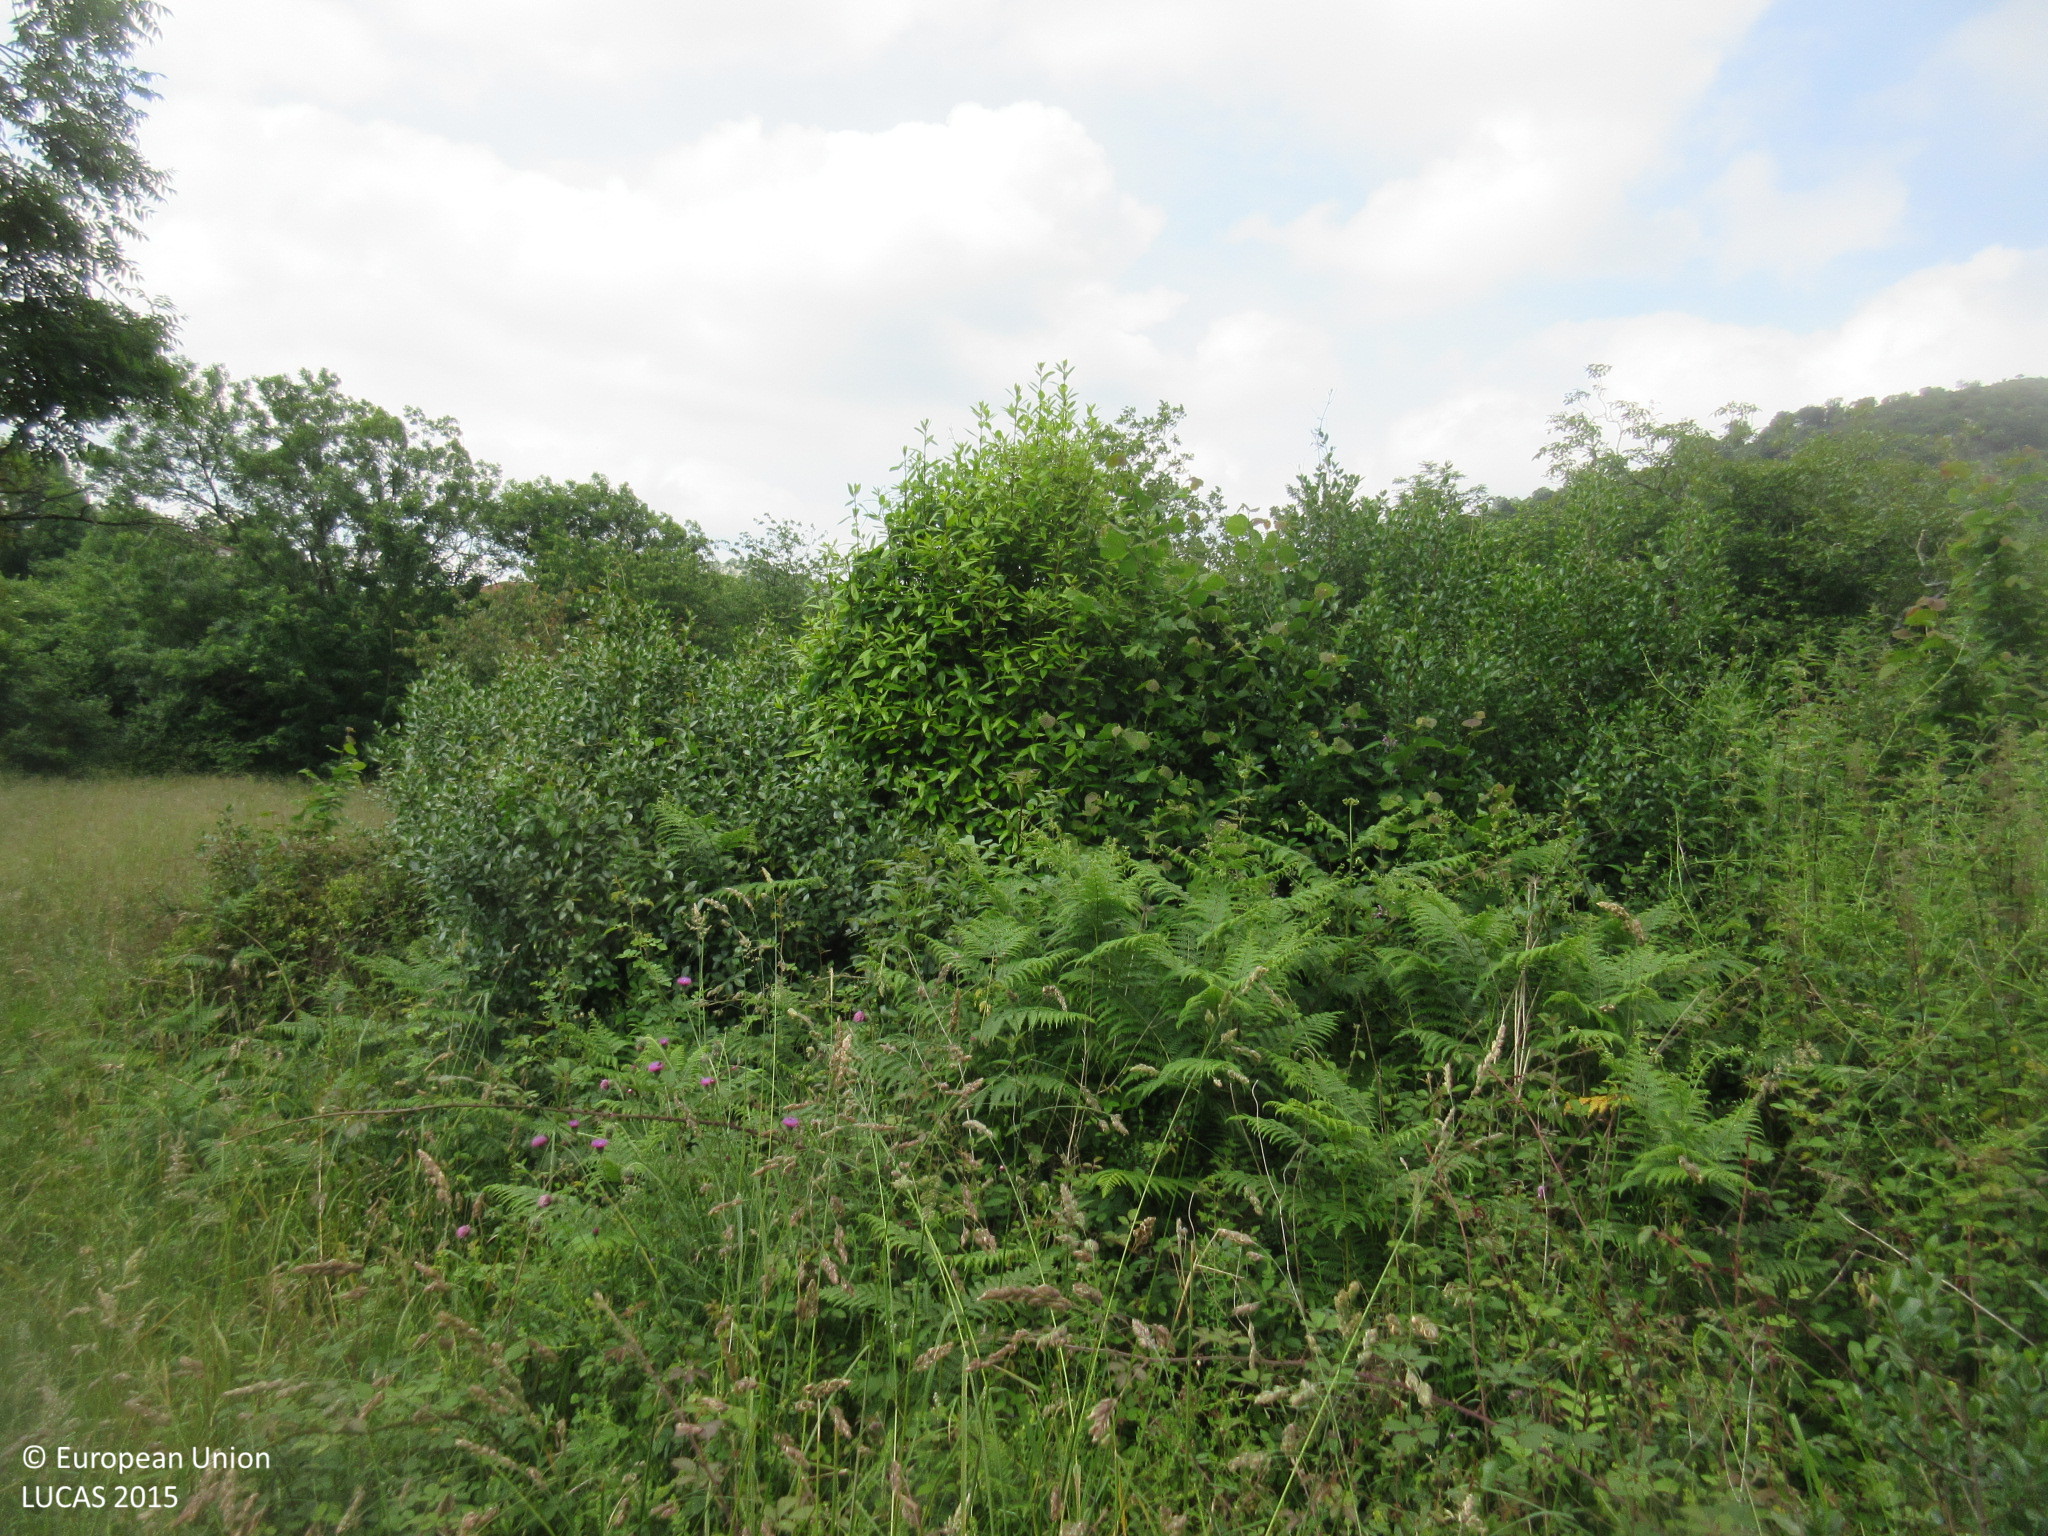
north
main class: Shrubland
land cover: Shrubland without tree cover
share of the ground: > 75 %
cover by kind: shrubs 90 %, herbaceous plants 10 %
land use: Agriculture (excluding fallow land and kitchen gardens)
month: June
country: ES
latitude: 43.2868
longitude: -5.9756
